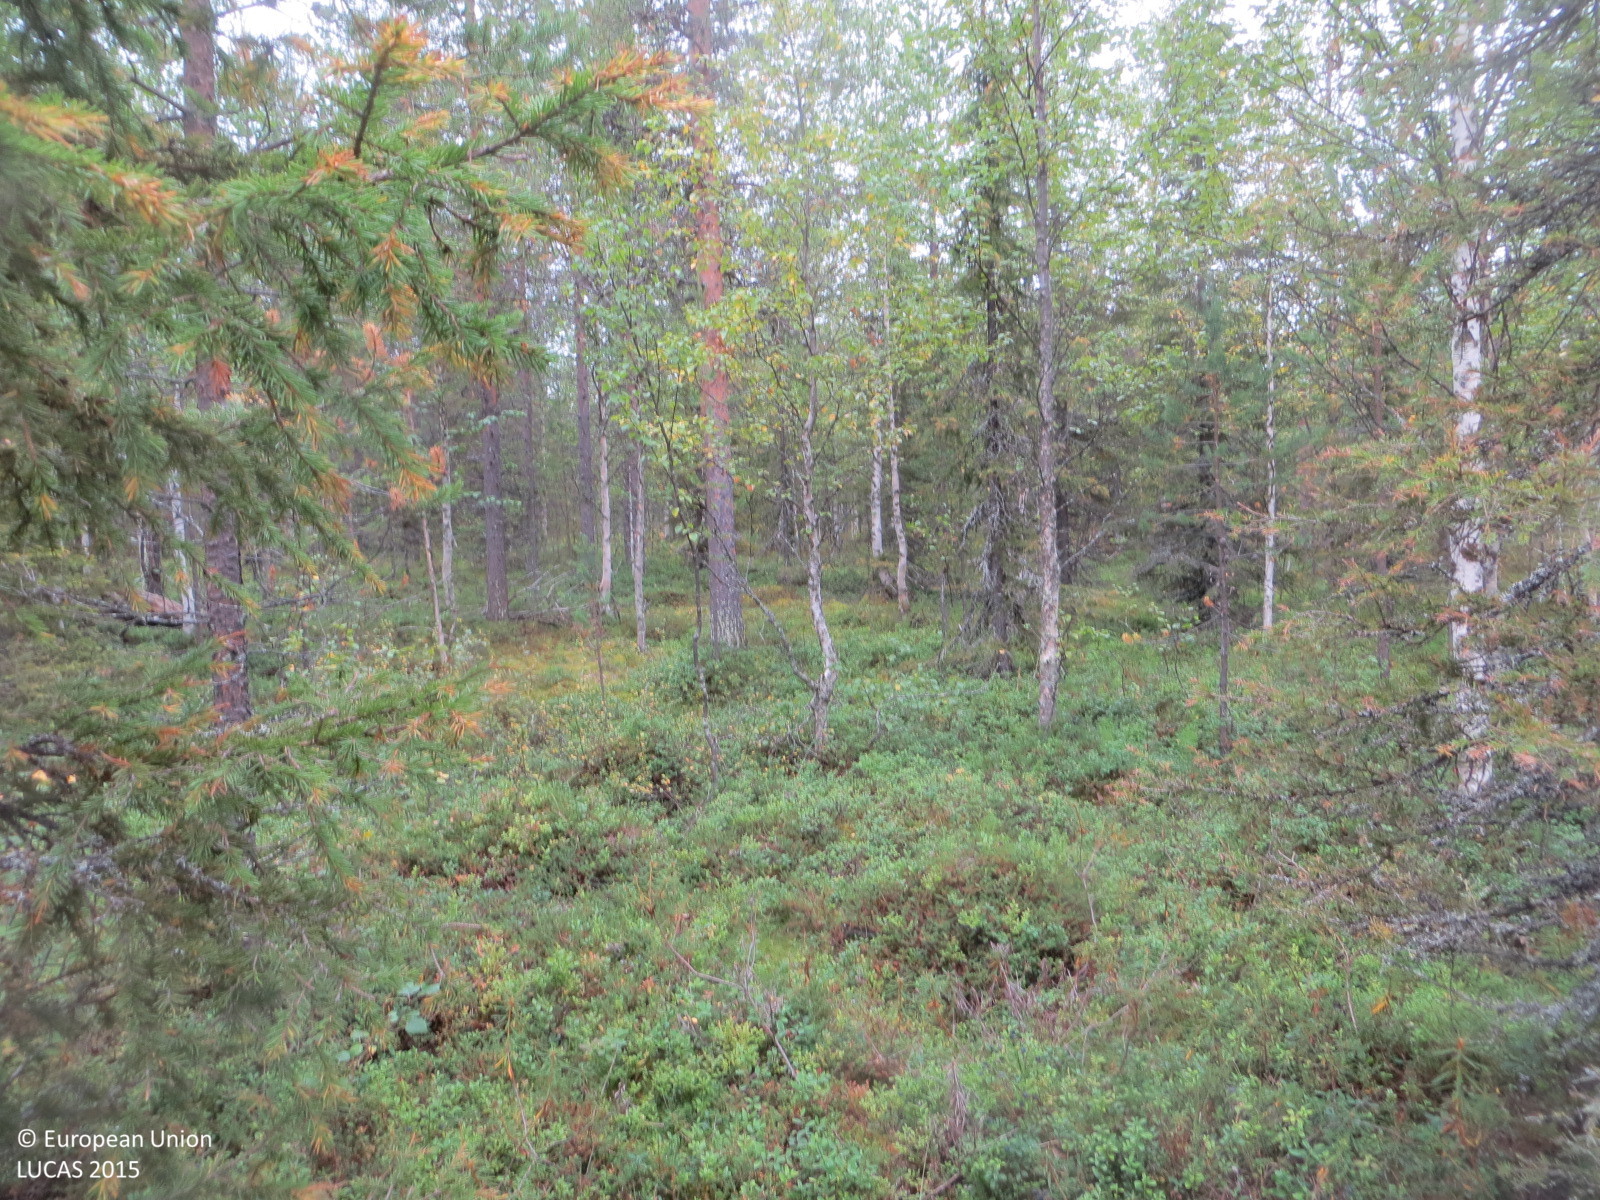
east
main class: Woodland
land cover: Other mixed woodland
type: boreal forest
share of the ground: 50 - 75 %
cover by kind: shrubs 50 %, broadleaved forest trees 30 %, coniferous forest trees 20 %
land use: Forestry
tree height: > 5 m
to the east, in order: Other mixed woodland; Pine dominated mixed woodland; Pine dominated coniferous woodland; Pine dominated mixed woodland; Pine dominated coniferous woodland
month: August
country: FI
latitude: 67.5256
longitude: 24.3508
